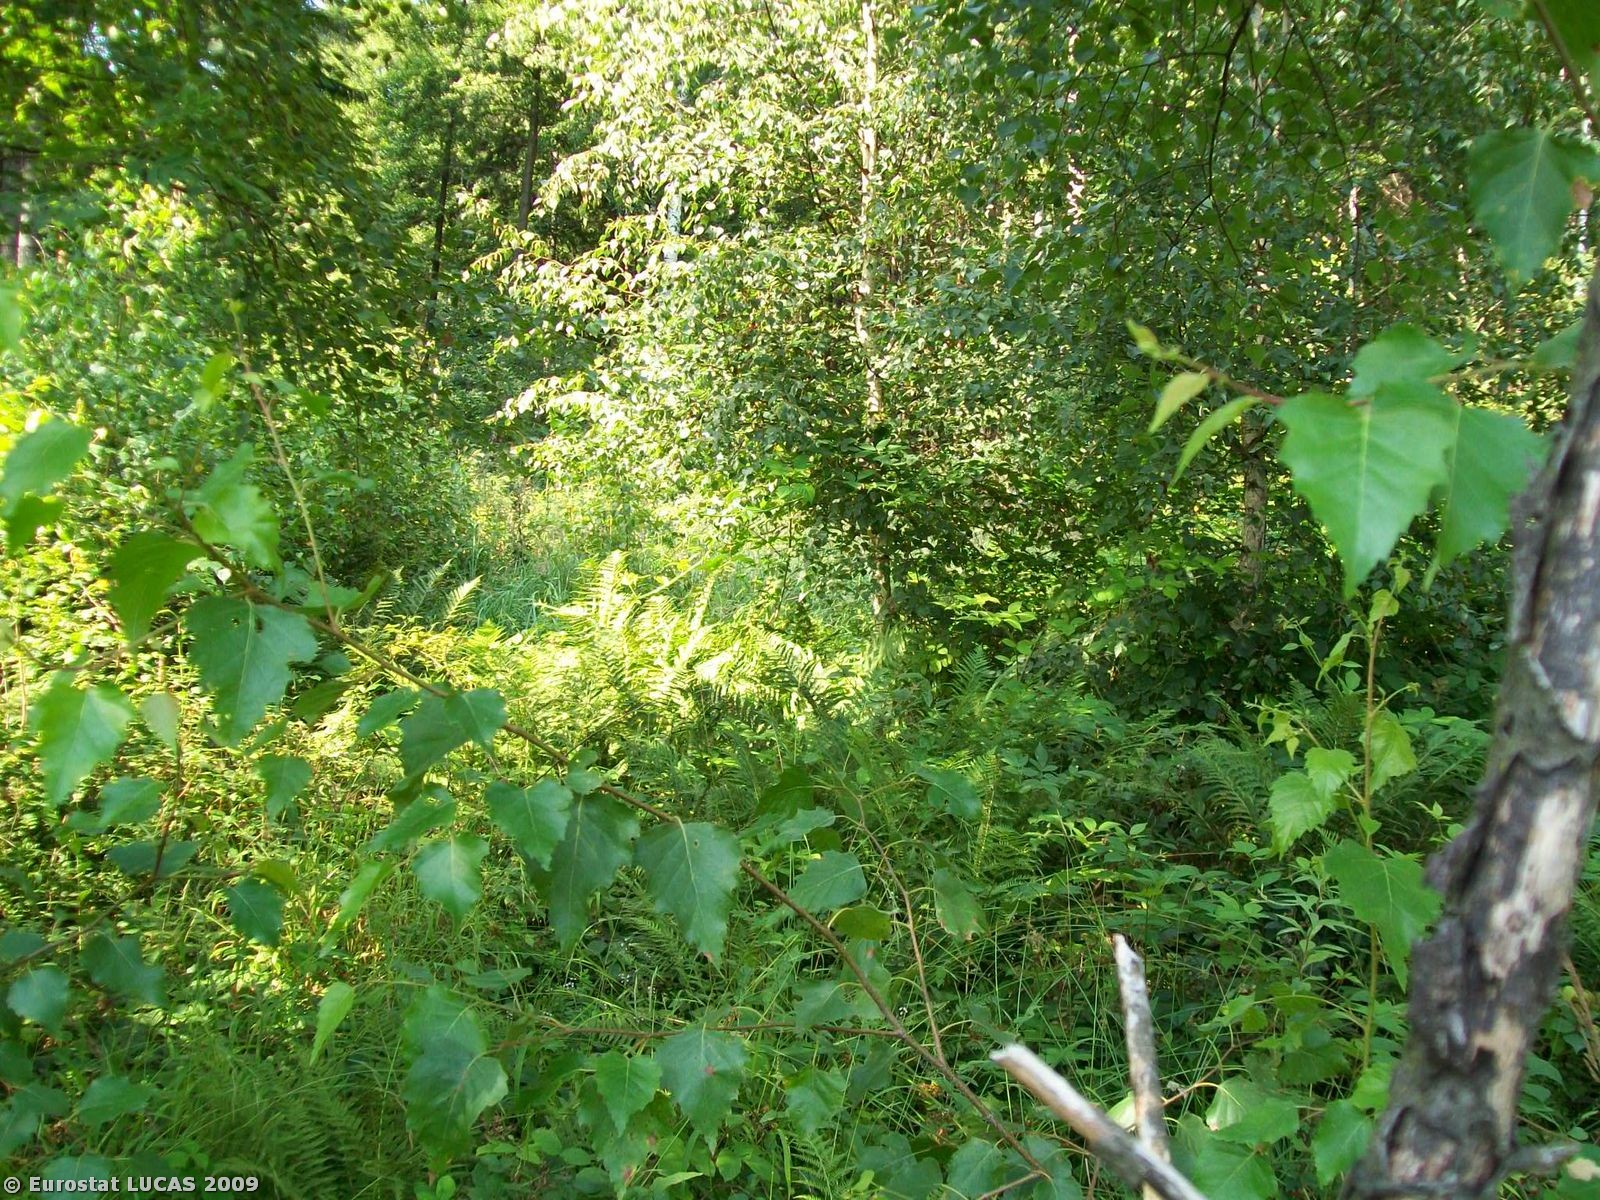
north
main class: Woodland
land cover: Mixed woodland
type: hemiboreal forest and nemoral coniferous forest and mixed broadleaved-coniferous forest
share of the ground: > 75 %
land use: Nature reserves
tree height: > 5 m
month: August
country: PL
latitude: 50.8516
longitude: 16.7275
